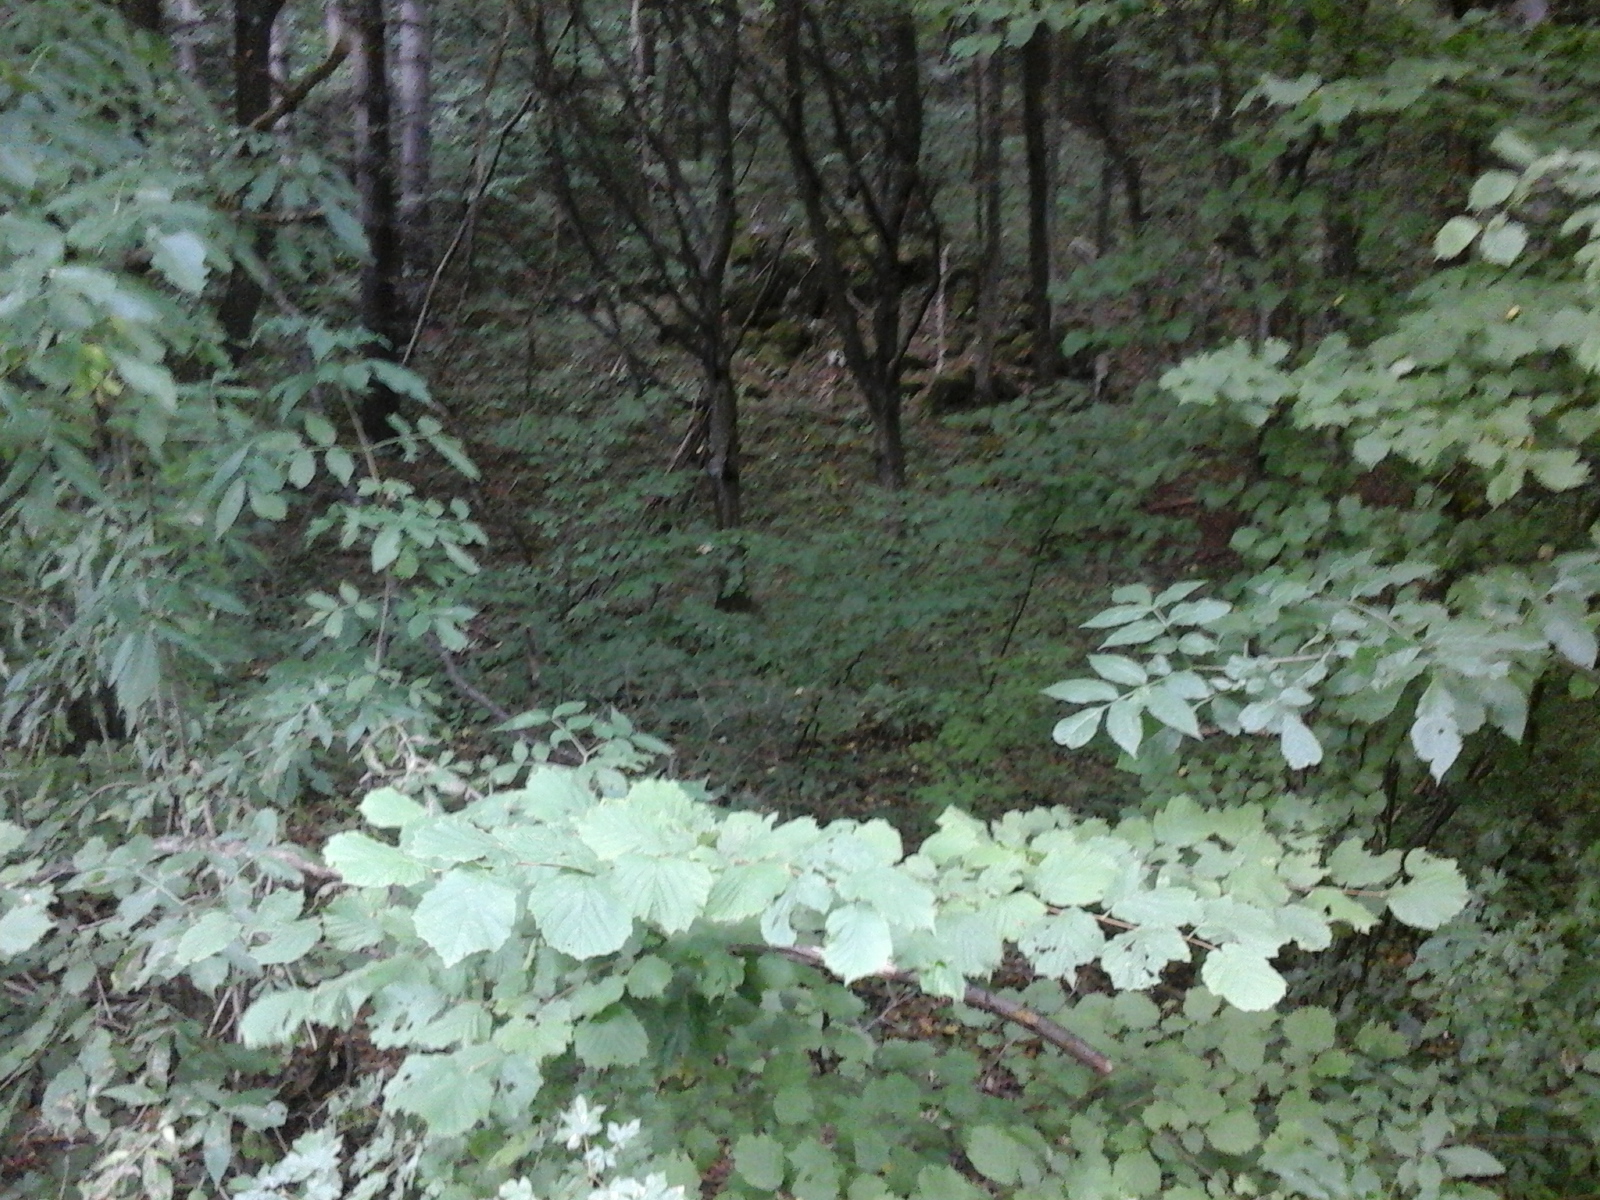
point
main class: Woodland
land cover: Broadleaved woodland
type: beech forest
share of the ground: > 75 %
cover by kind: broadleaved forest trees 100 %
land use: Forestry
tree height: > 5 m
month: August
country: RO
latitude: 45.1412
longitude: 21.8742
